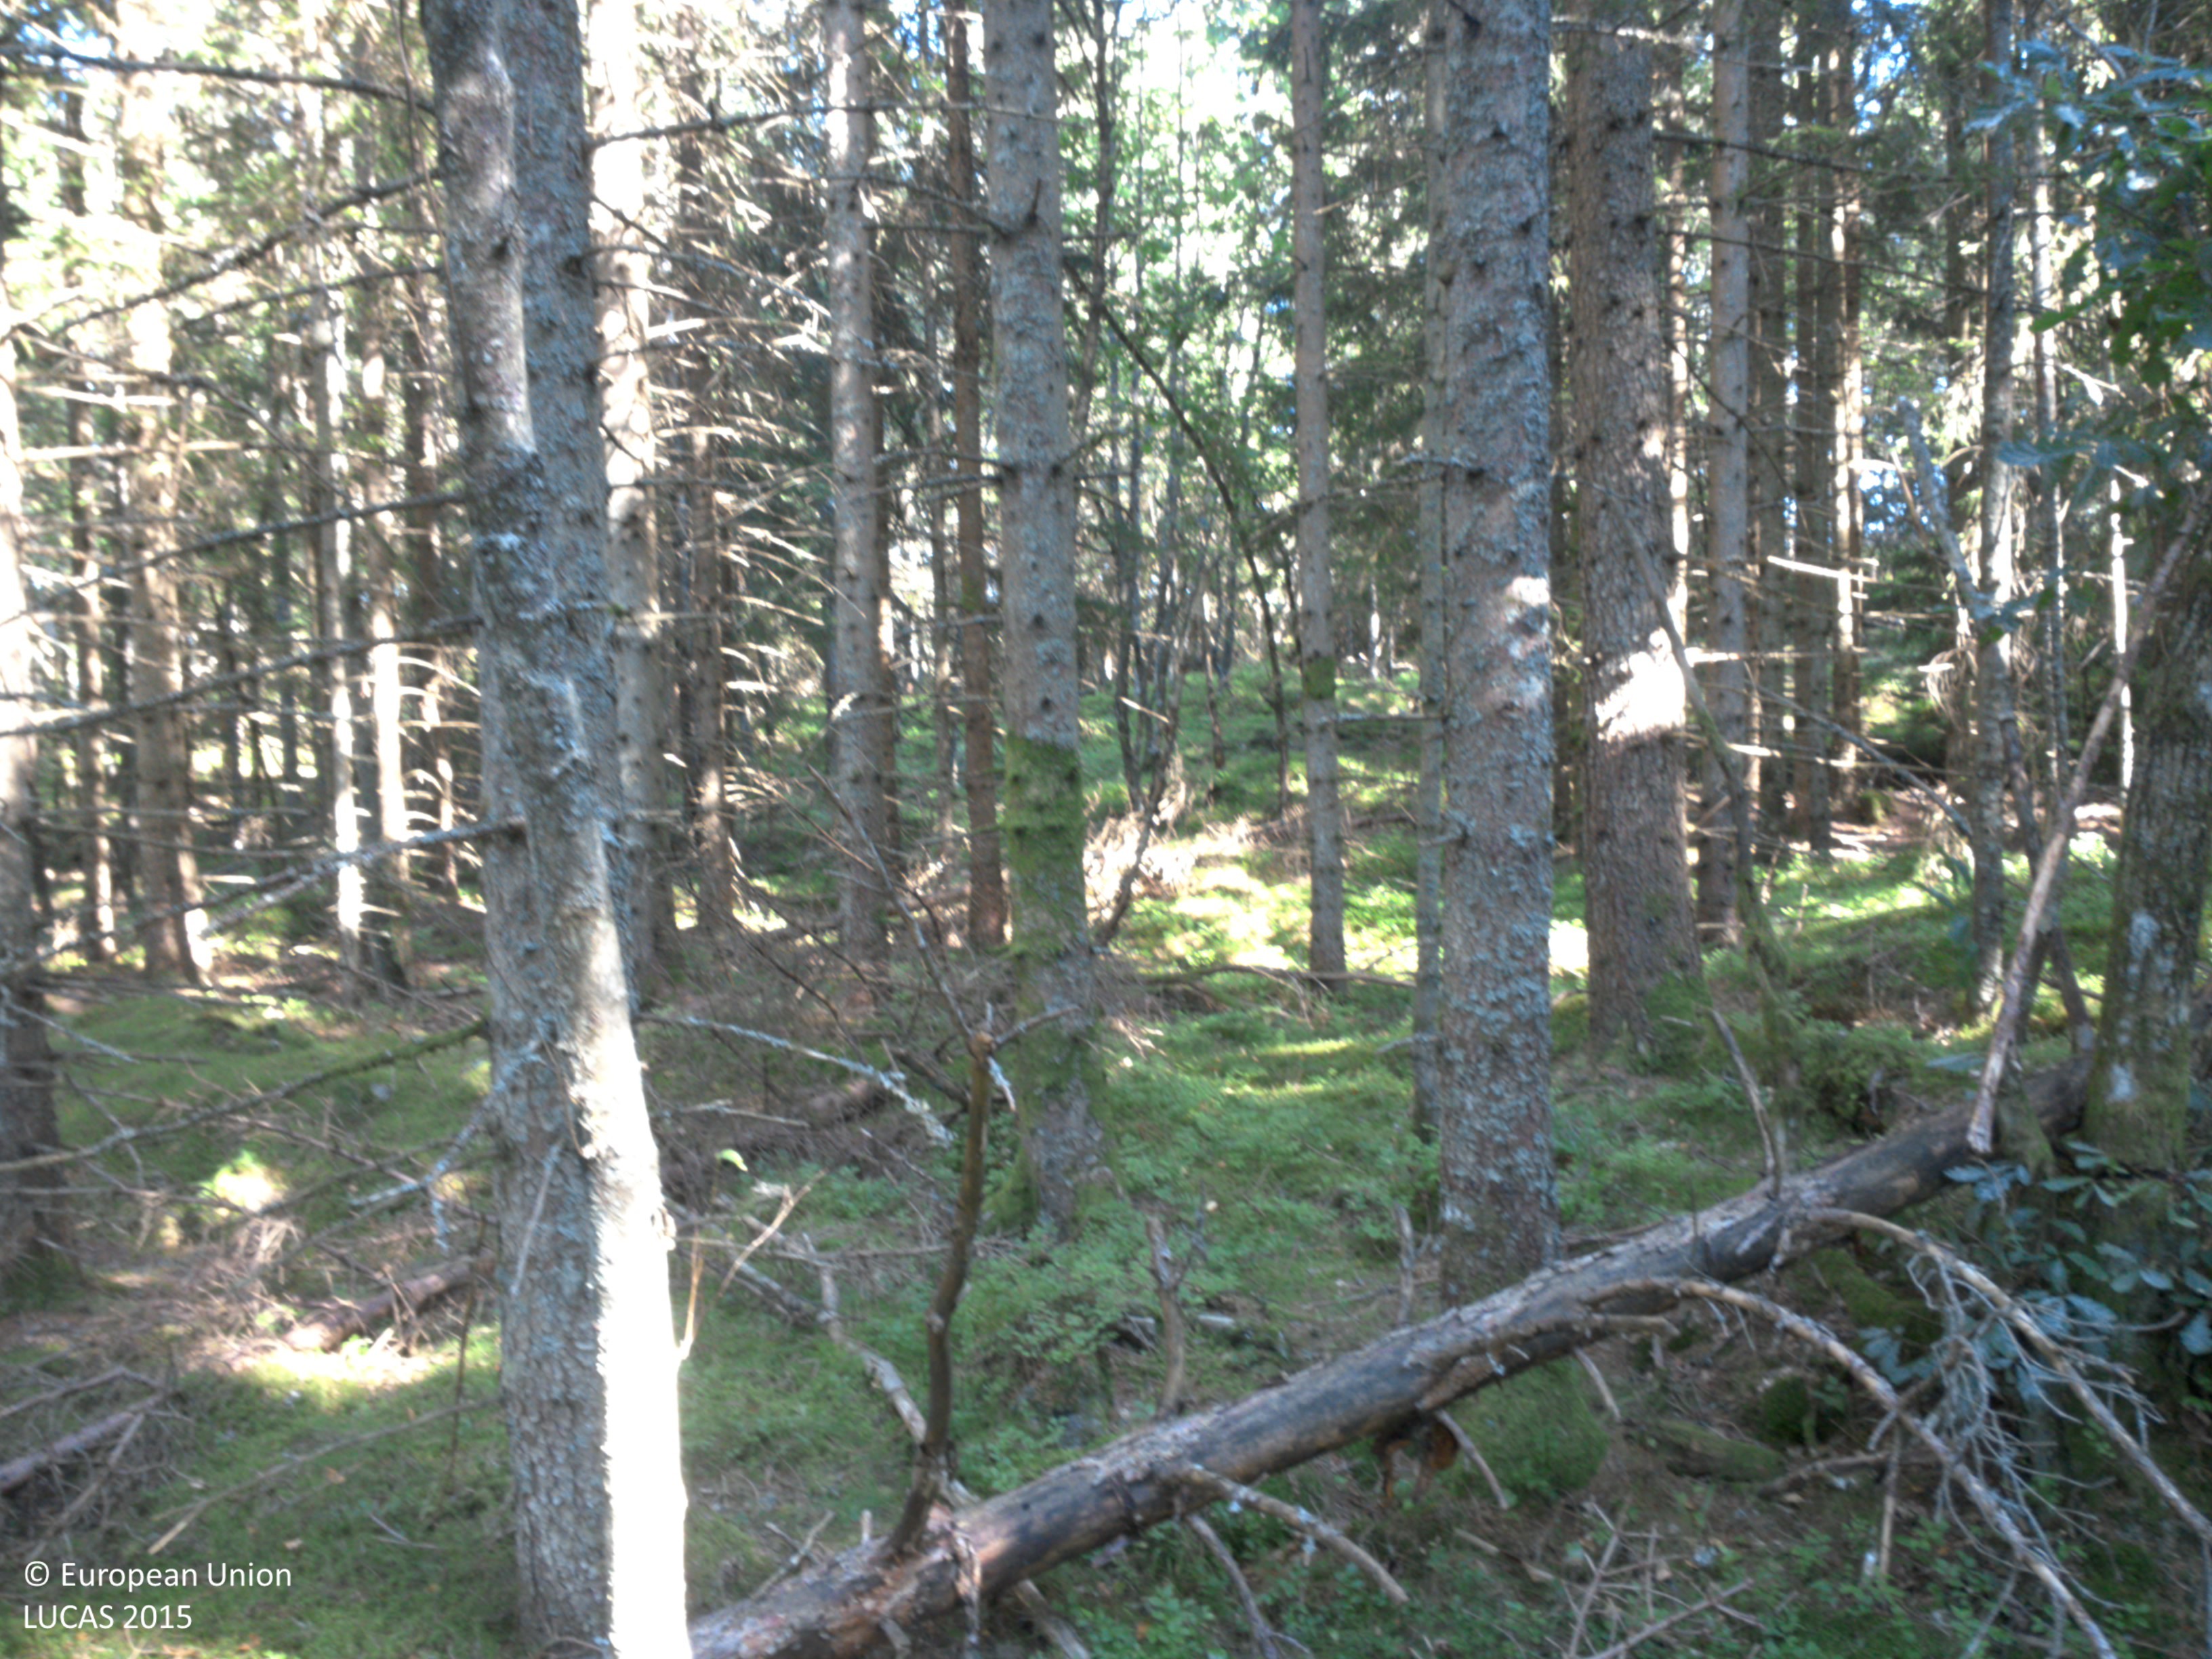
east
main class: Woodland
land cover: Spruce dominated coniferous woodland
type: boreal forest
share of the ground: > 75 %
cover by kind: coniferous forest trees 75 %, shrubs 10 %, lichens and mosses 10 %, herbaceous plants 5 %
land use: Forestry
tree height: > 5 m
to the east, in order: Spruce dominated coniferous woodland; Spruce dominated mixed woodland; Pine dominated coniferous woodland; Rock outcrops; Spruce dominated mixed woodland; Spruce dominated coniferous woodland
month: August
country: SE
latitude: 58.5813
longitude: 12.0767
